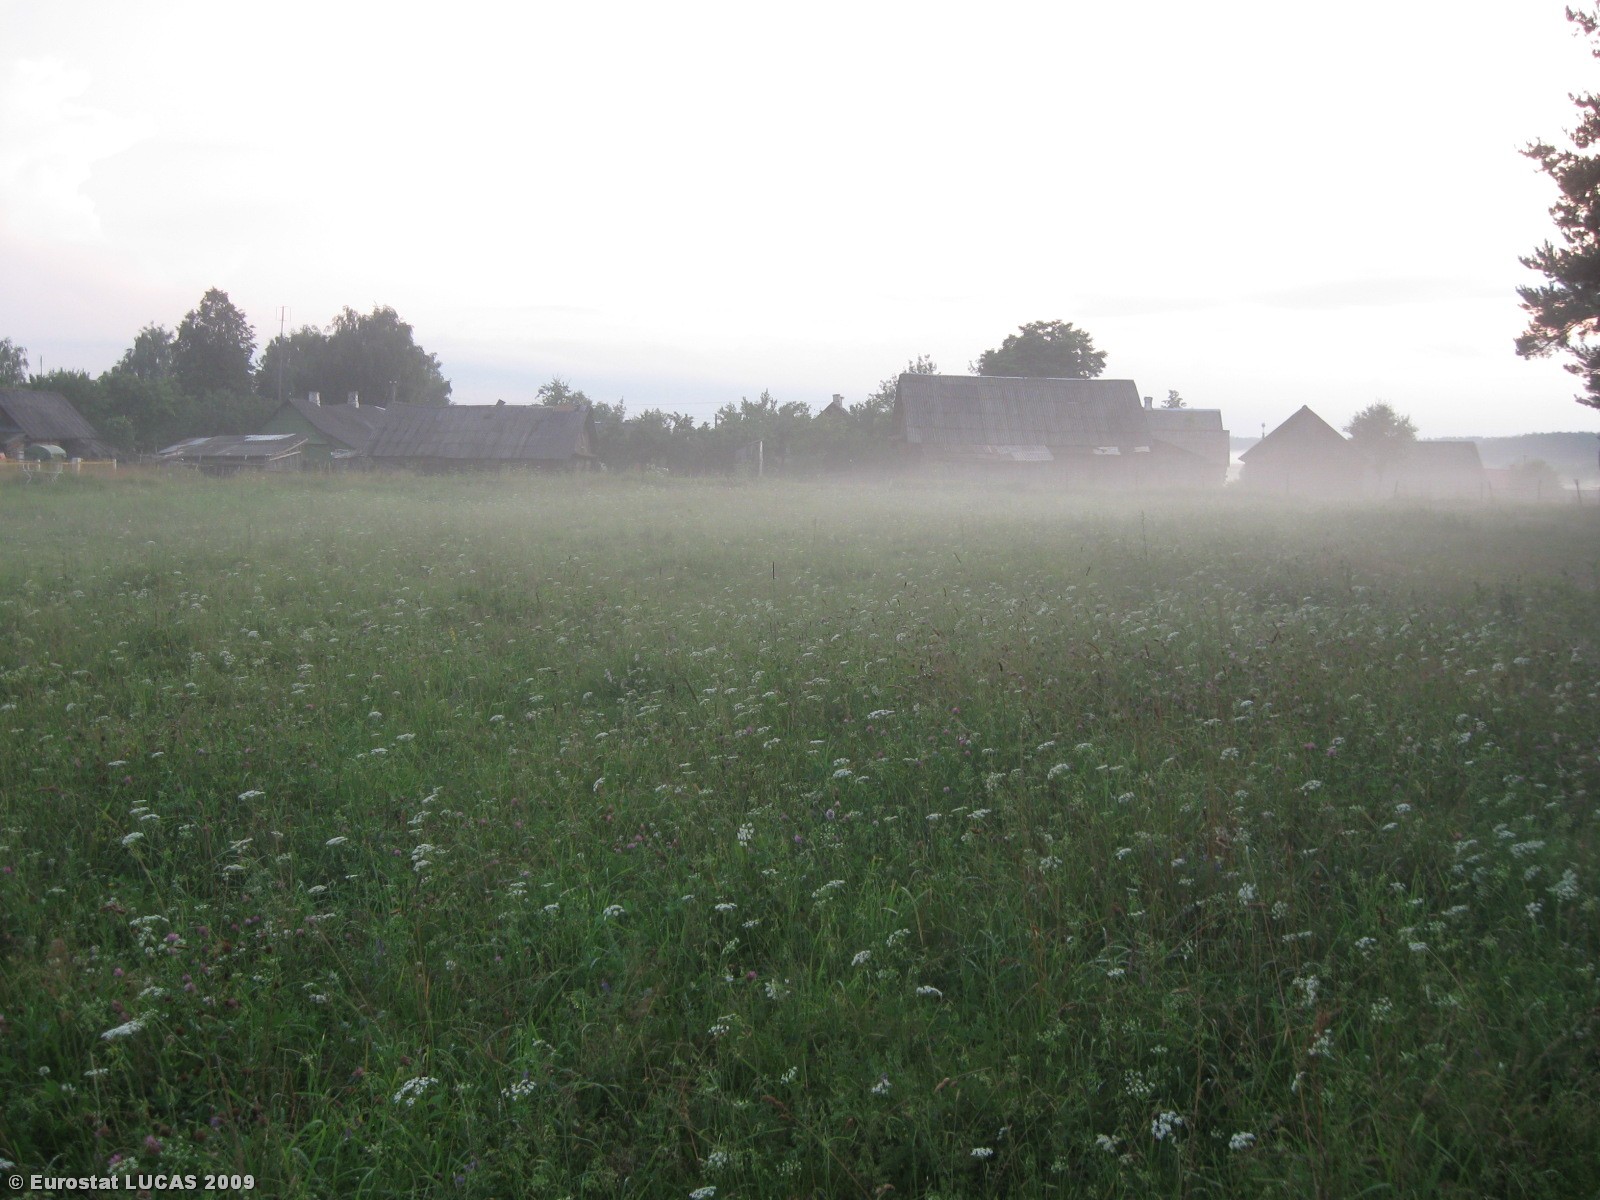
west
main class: Grassland
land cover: Grassland without tree/shrub cover
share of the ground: > 75 %
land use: Agriculture (excluding fallow land and kitchen gardens)
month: July
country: LT
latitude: 54.2872
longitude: 25.0322
